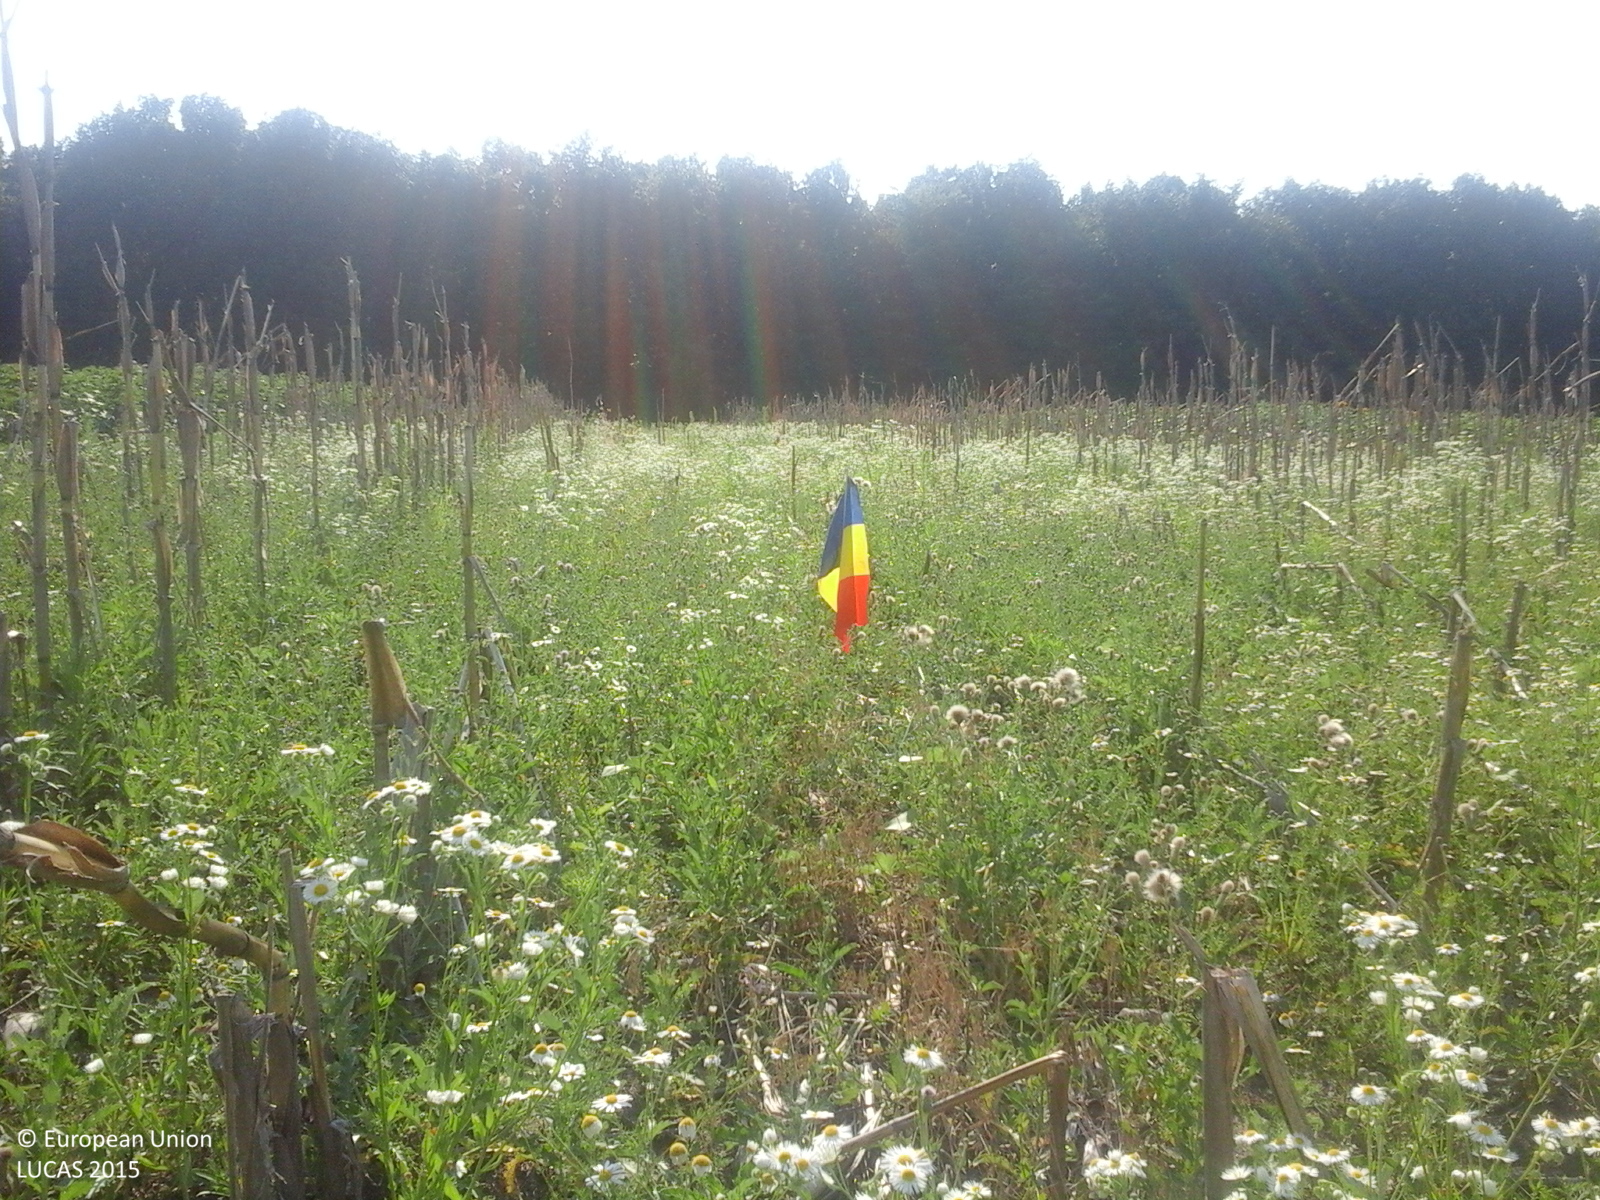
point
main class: Grassland
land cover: Spontaneously vegetated surfaces
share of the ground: > 75 %
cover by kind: herbaceous plants 100 %
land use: Fallow land
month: July
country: RO
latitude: 44.5329
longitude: 24.7621
